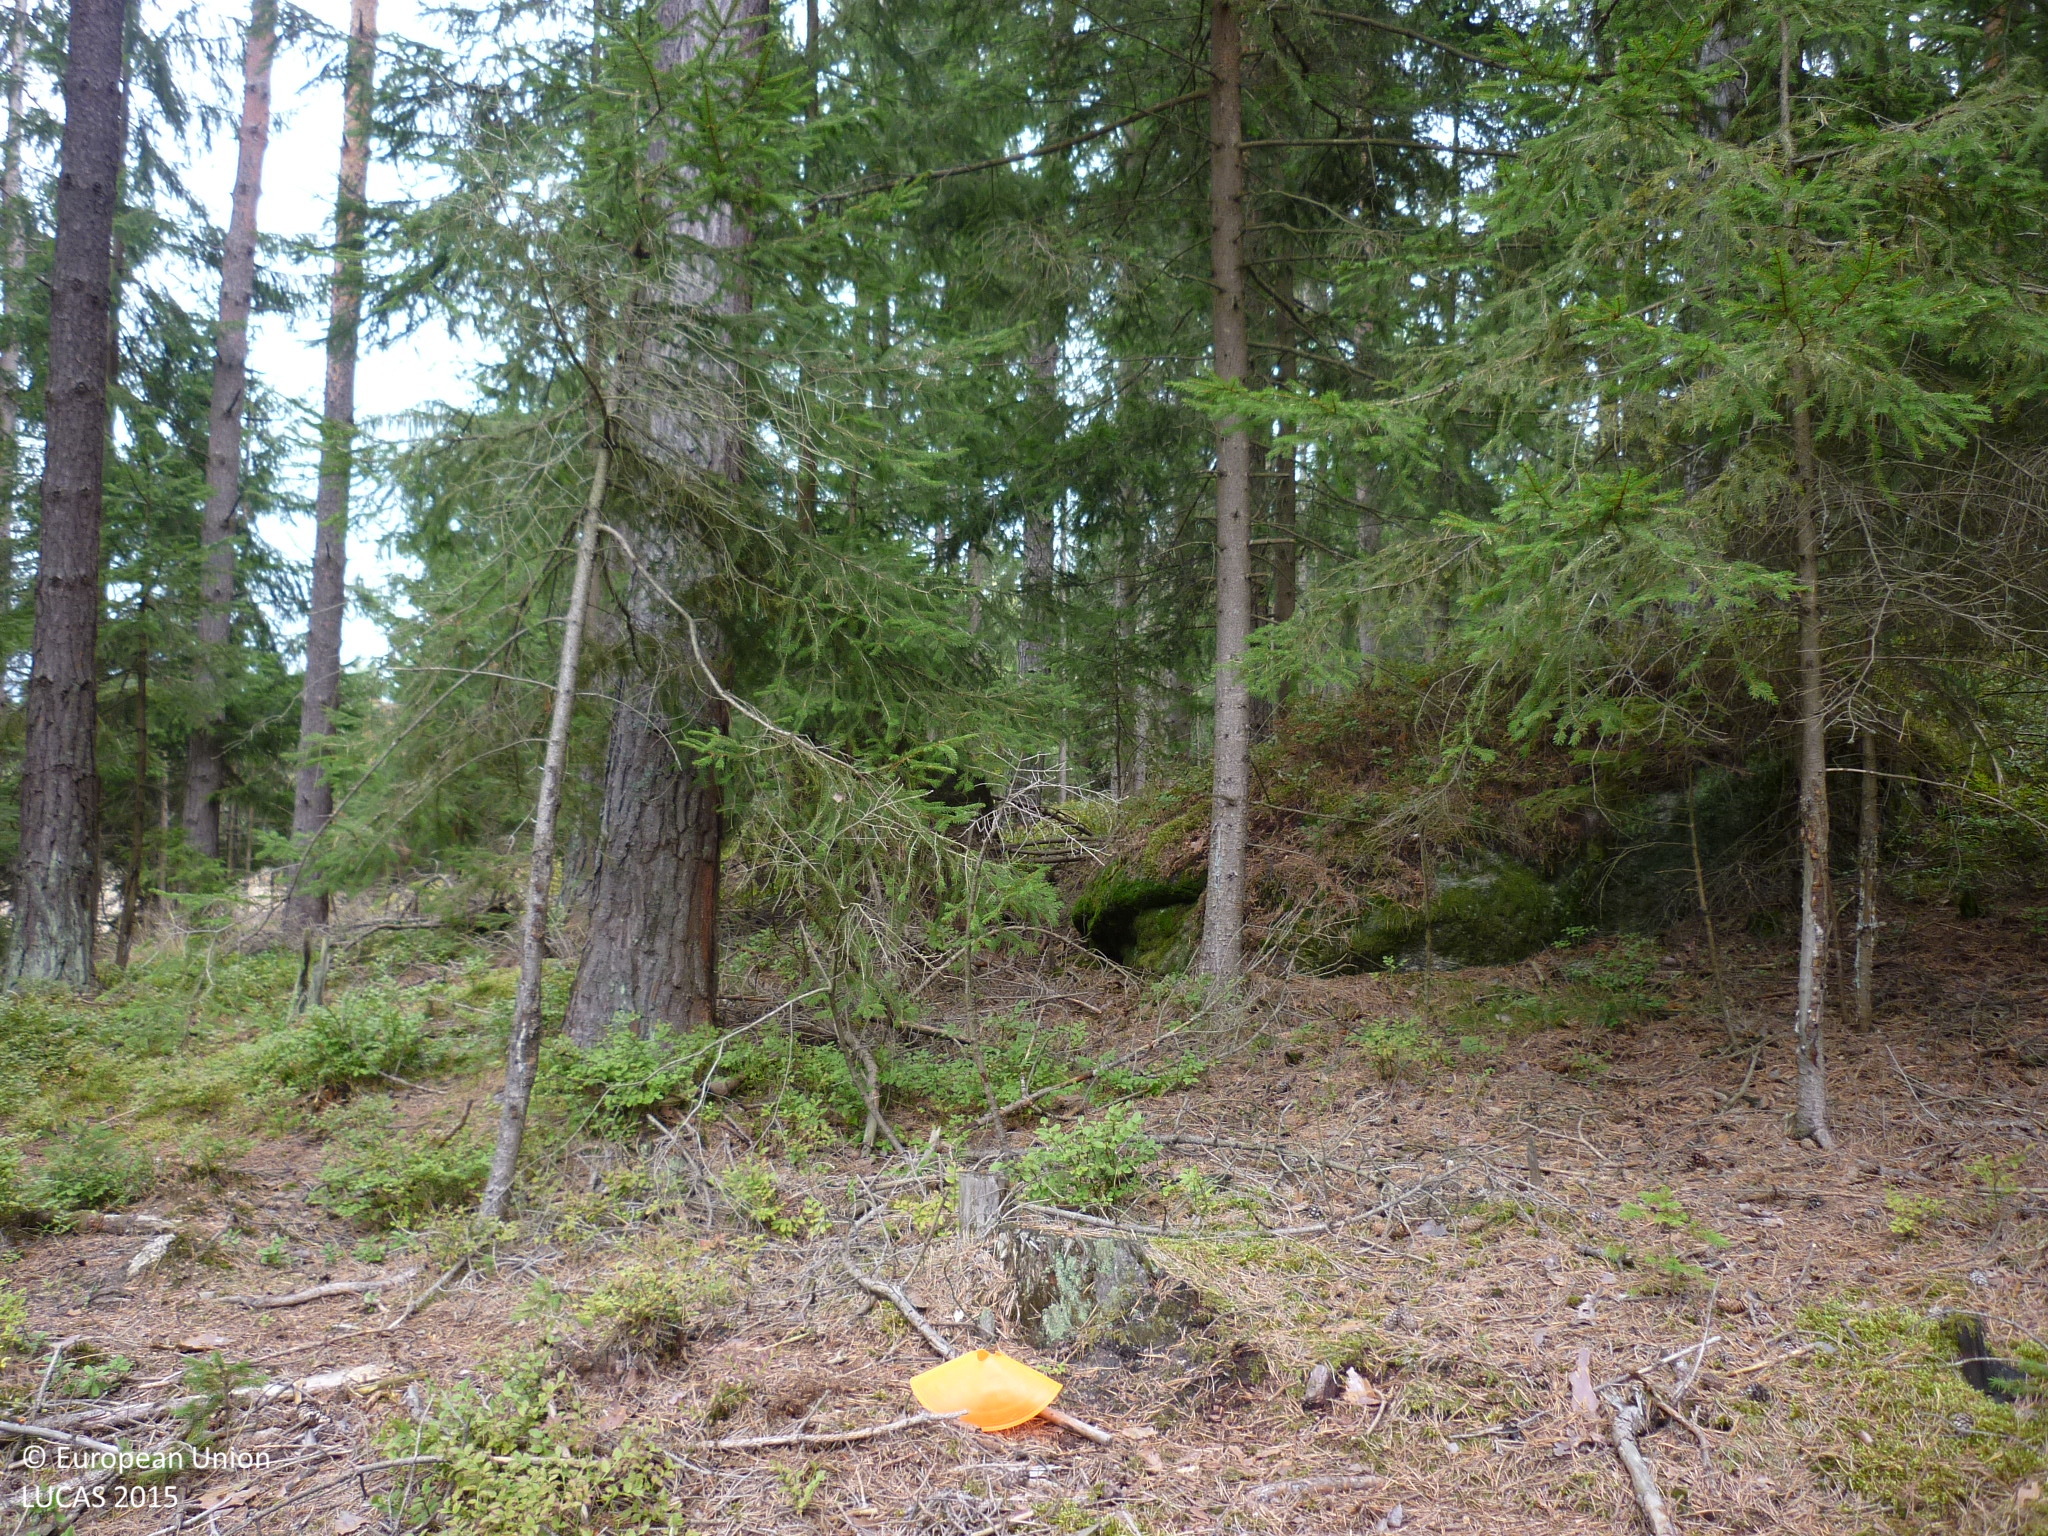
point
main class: Woodland
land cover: Spruce dominated coniferous woodland
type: hemiboreal forest and nemoral coniferous forest and mixed broadleaved-coniferous forest
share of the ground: > 75 %
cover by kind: coniferous forest trees 100 %
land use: Forestry
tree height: > 5 m
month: September
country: AT
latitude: 48.8479
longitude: 15.0305
